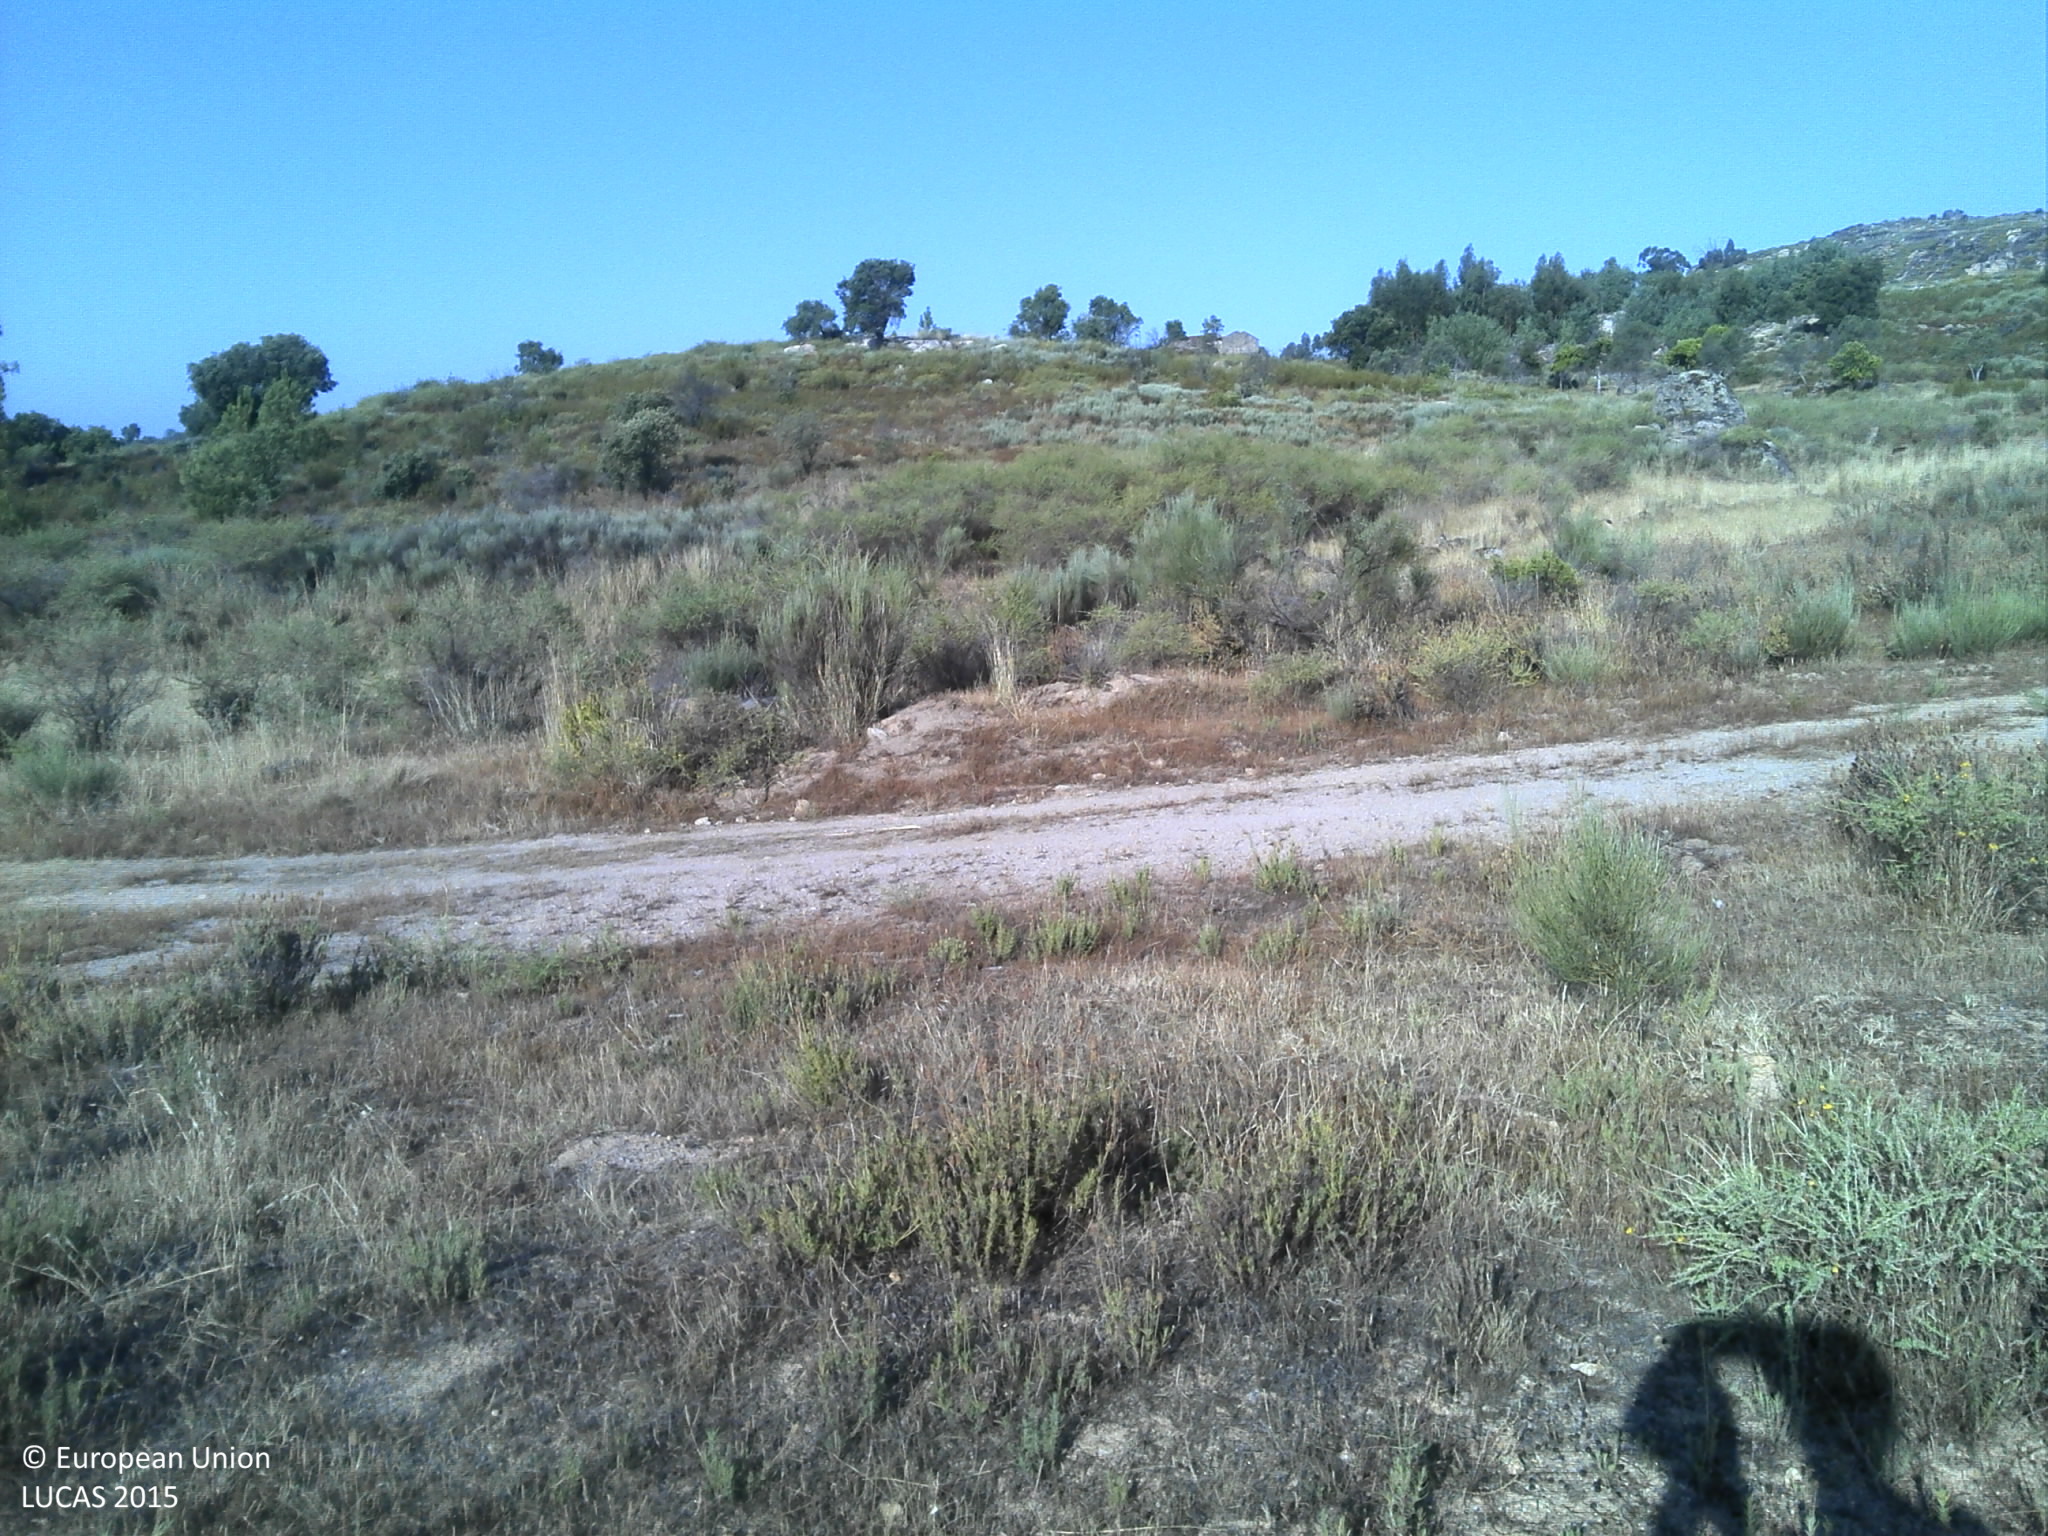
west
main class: Shrubland
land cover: Shrubland without tree cover
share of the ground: 50 - 75 %
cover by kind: shrubs 50 %, herbaceous plants 35 %, unconsolidated bare surface 10 %
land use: Forestry
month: June
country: PT
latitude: 40.0268
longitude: -7.0957
